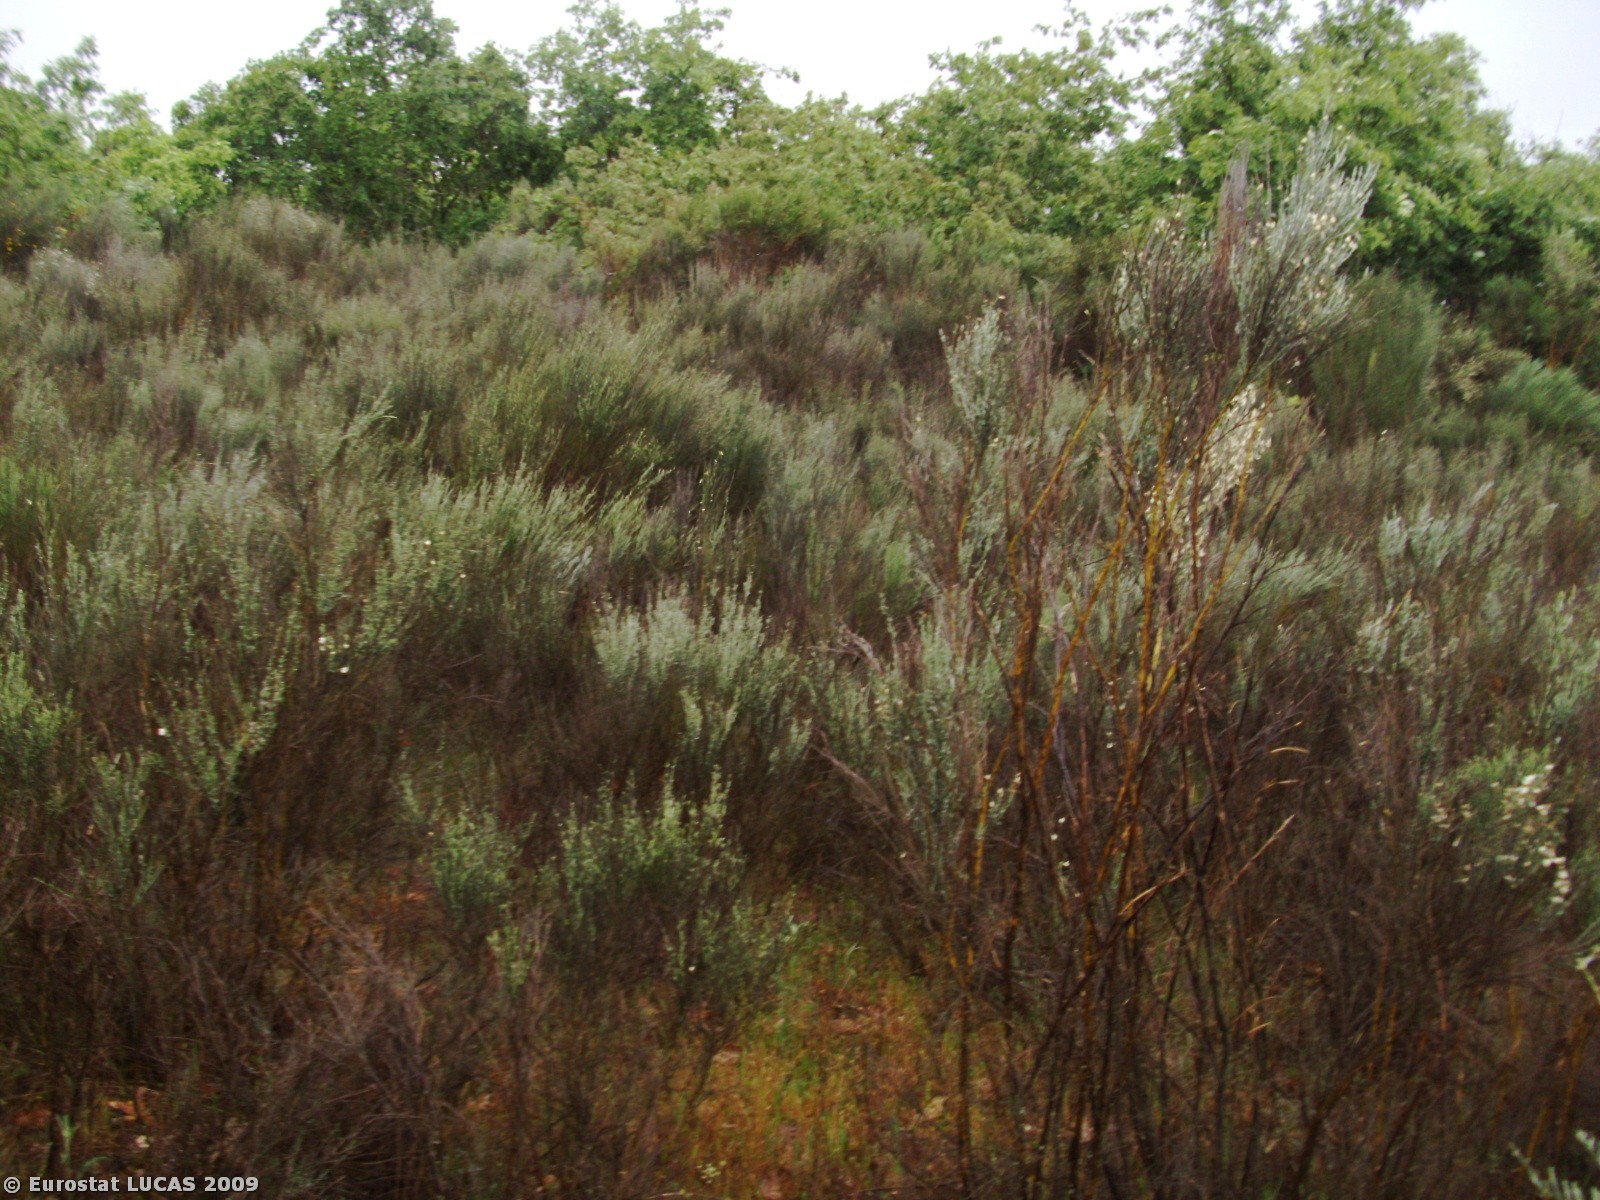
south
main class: Shrubland
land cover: Shrubland with sparse tree cover
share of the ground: > 75 %
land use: Unused
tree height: > 5 m
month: May
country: PT
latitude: 40.6219
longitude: -7.0658
